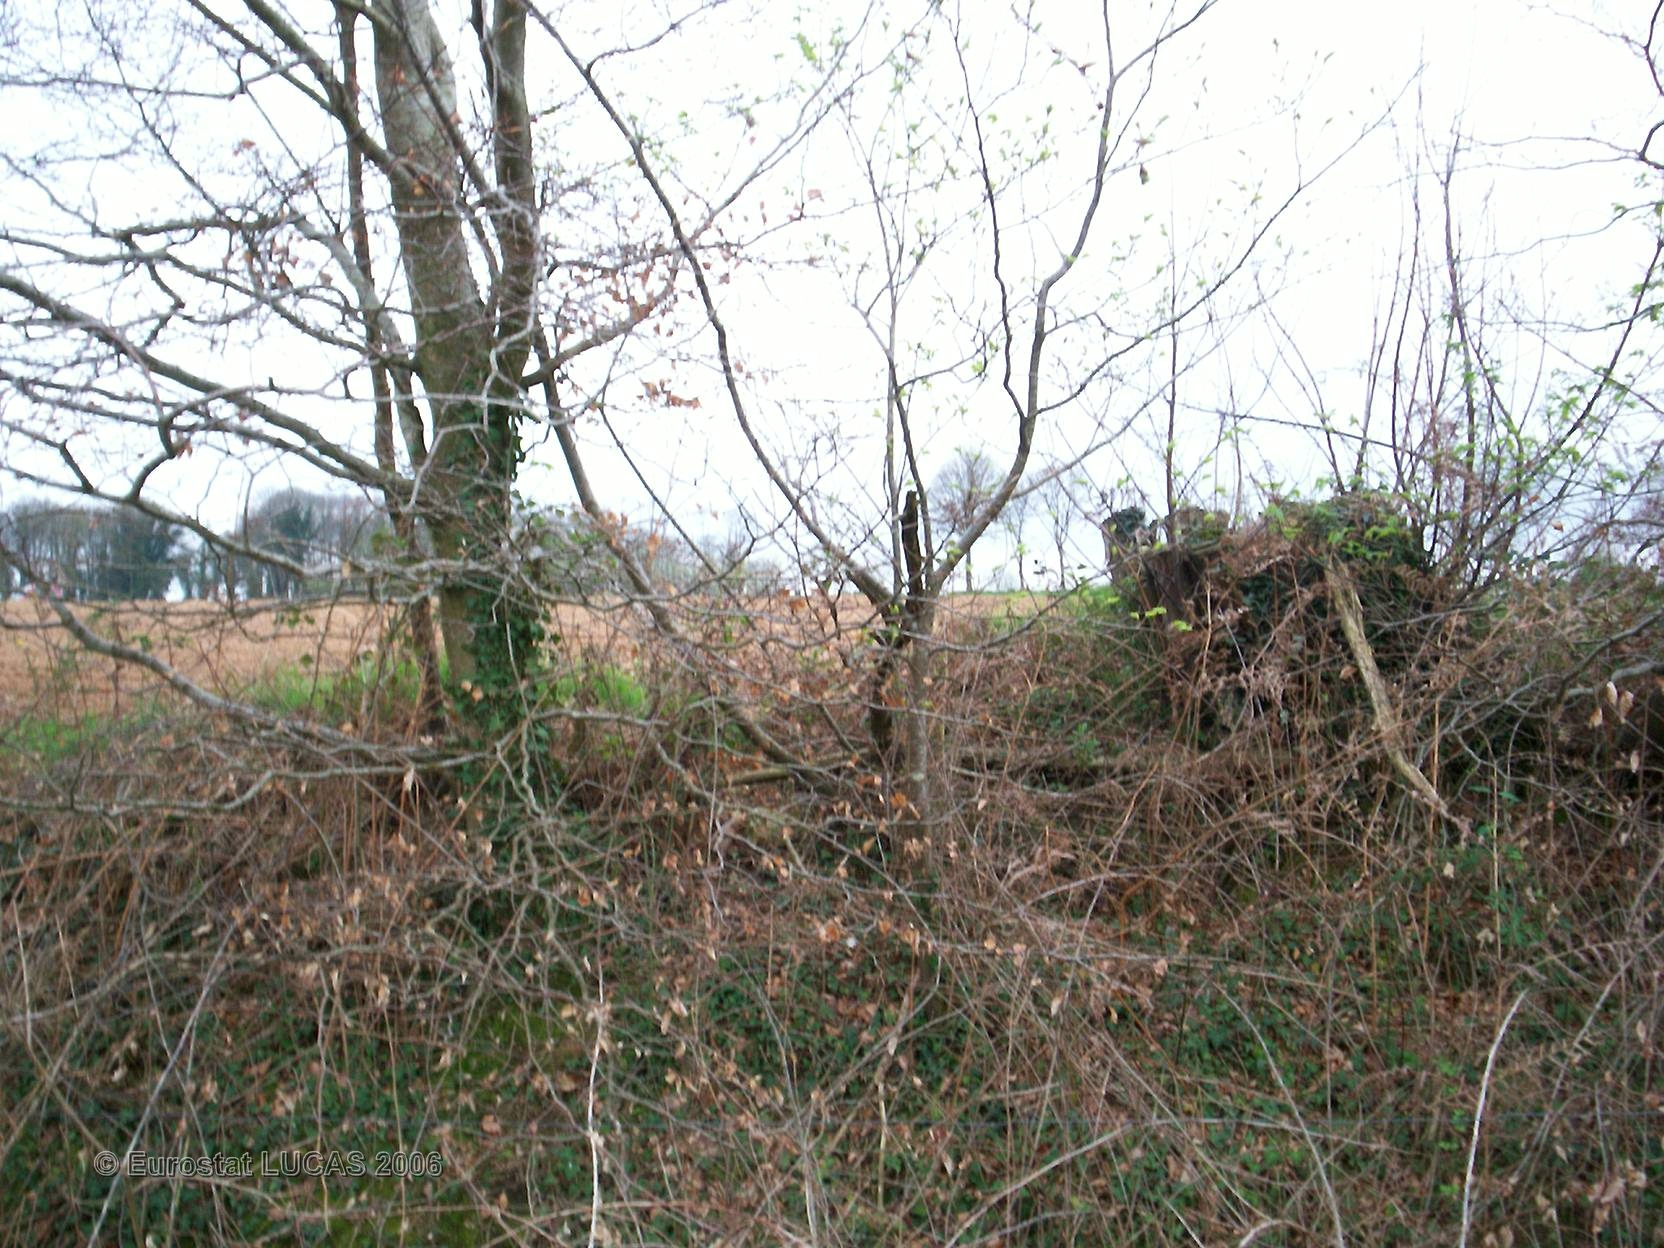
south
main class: Grassland
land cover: Grassland without tree/shrub cover
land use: Agriculture (excluding fallow land and kitchen gardens)
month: April
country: FR
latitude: 48.0821
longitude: -2.4221
